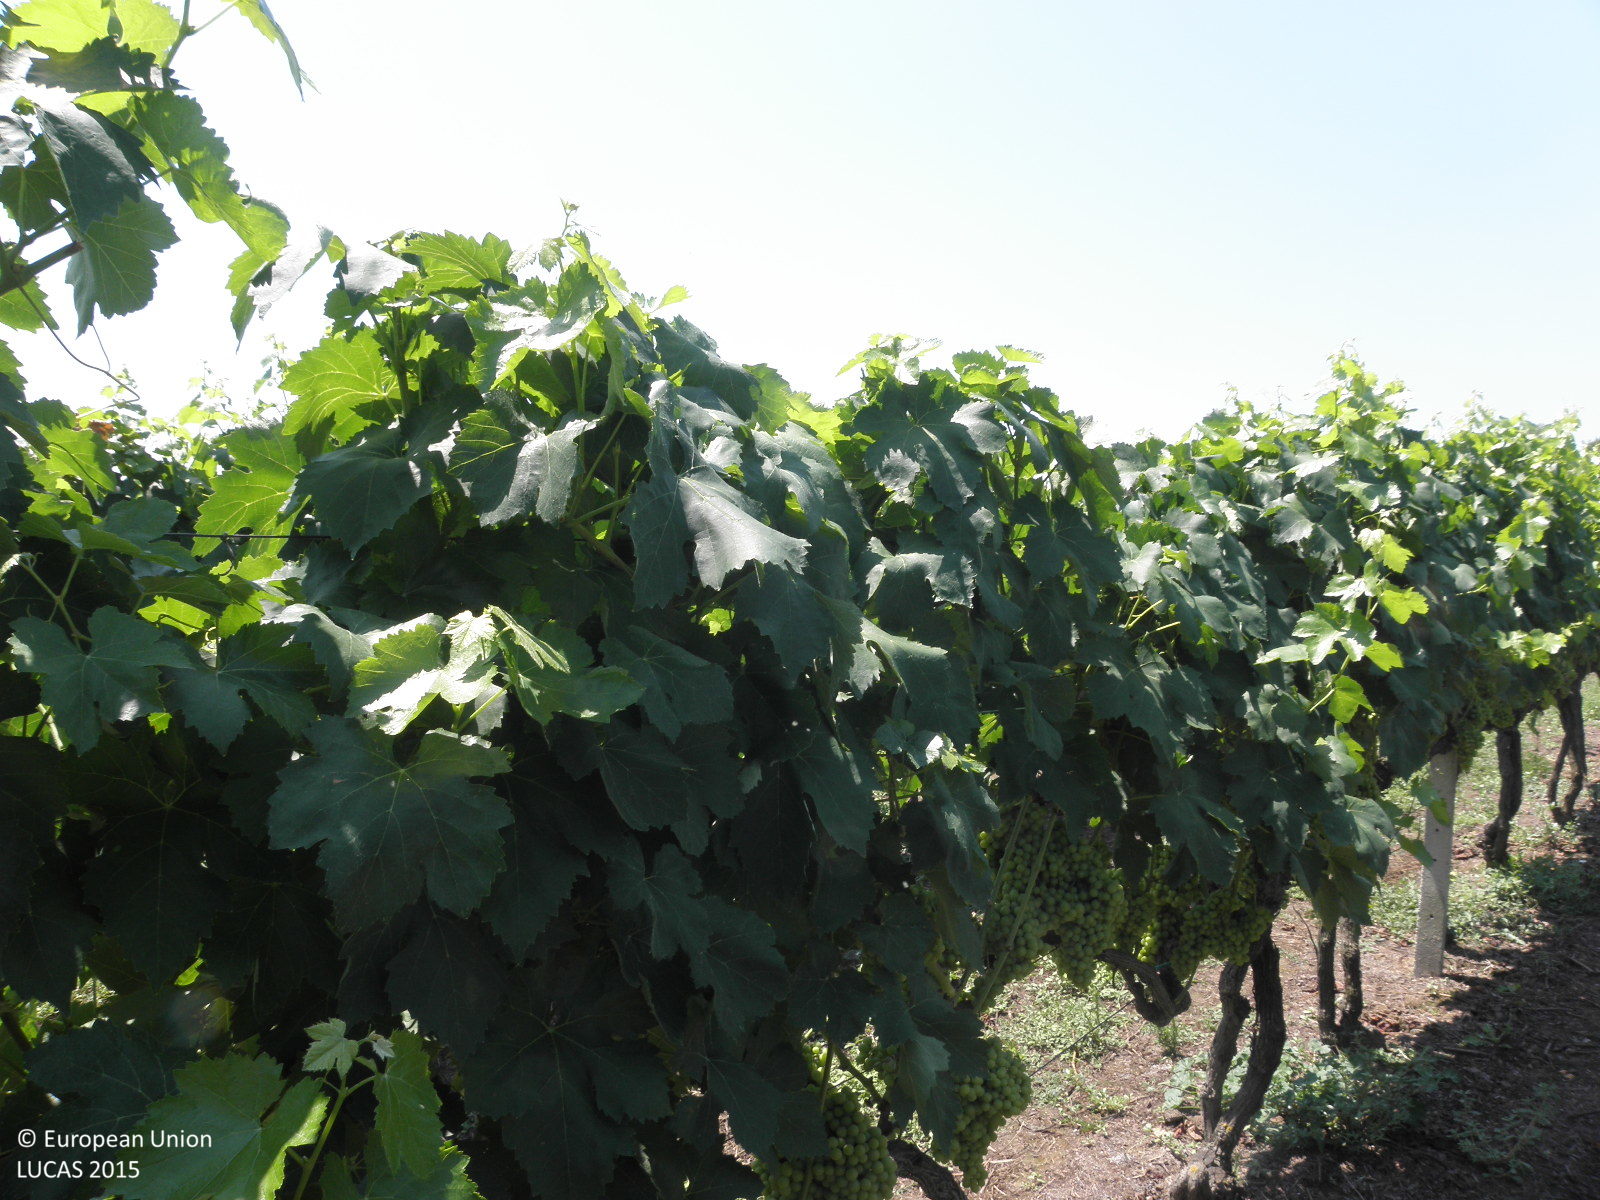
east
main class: Cropland
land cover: Vineyards
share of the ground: > 75 %
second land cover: Grassland without tree/shrub cover
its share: 25 - 50 %
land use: Agriculture (excluding fallow land and kitchen gardens)
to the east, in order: Vineyards; Grassland without tree/shrub cover; Grass margins; Abandoned hedges; Ditches and canals; Abandoned hedges; Tracks; Grass margins; Olive groves; Shrubland with sparse tree cover; Paved roads, cycling and walking lanes
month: July
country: GR
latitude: 39.7579
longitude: 22.3515
